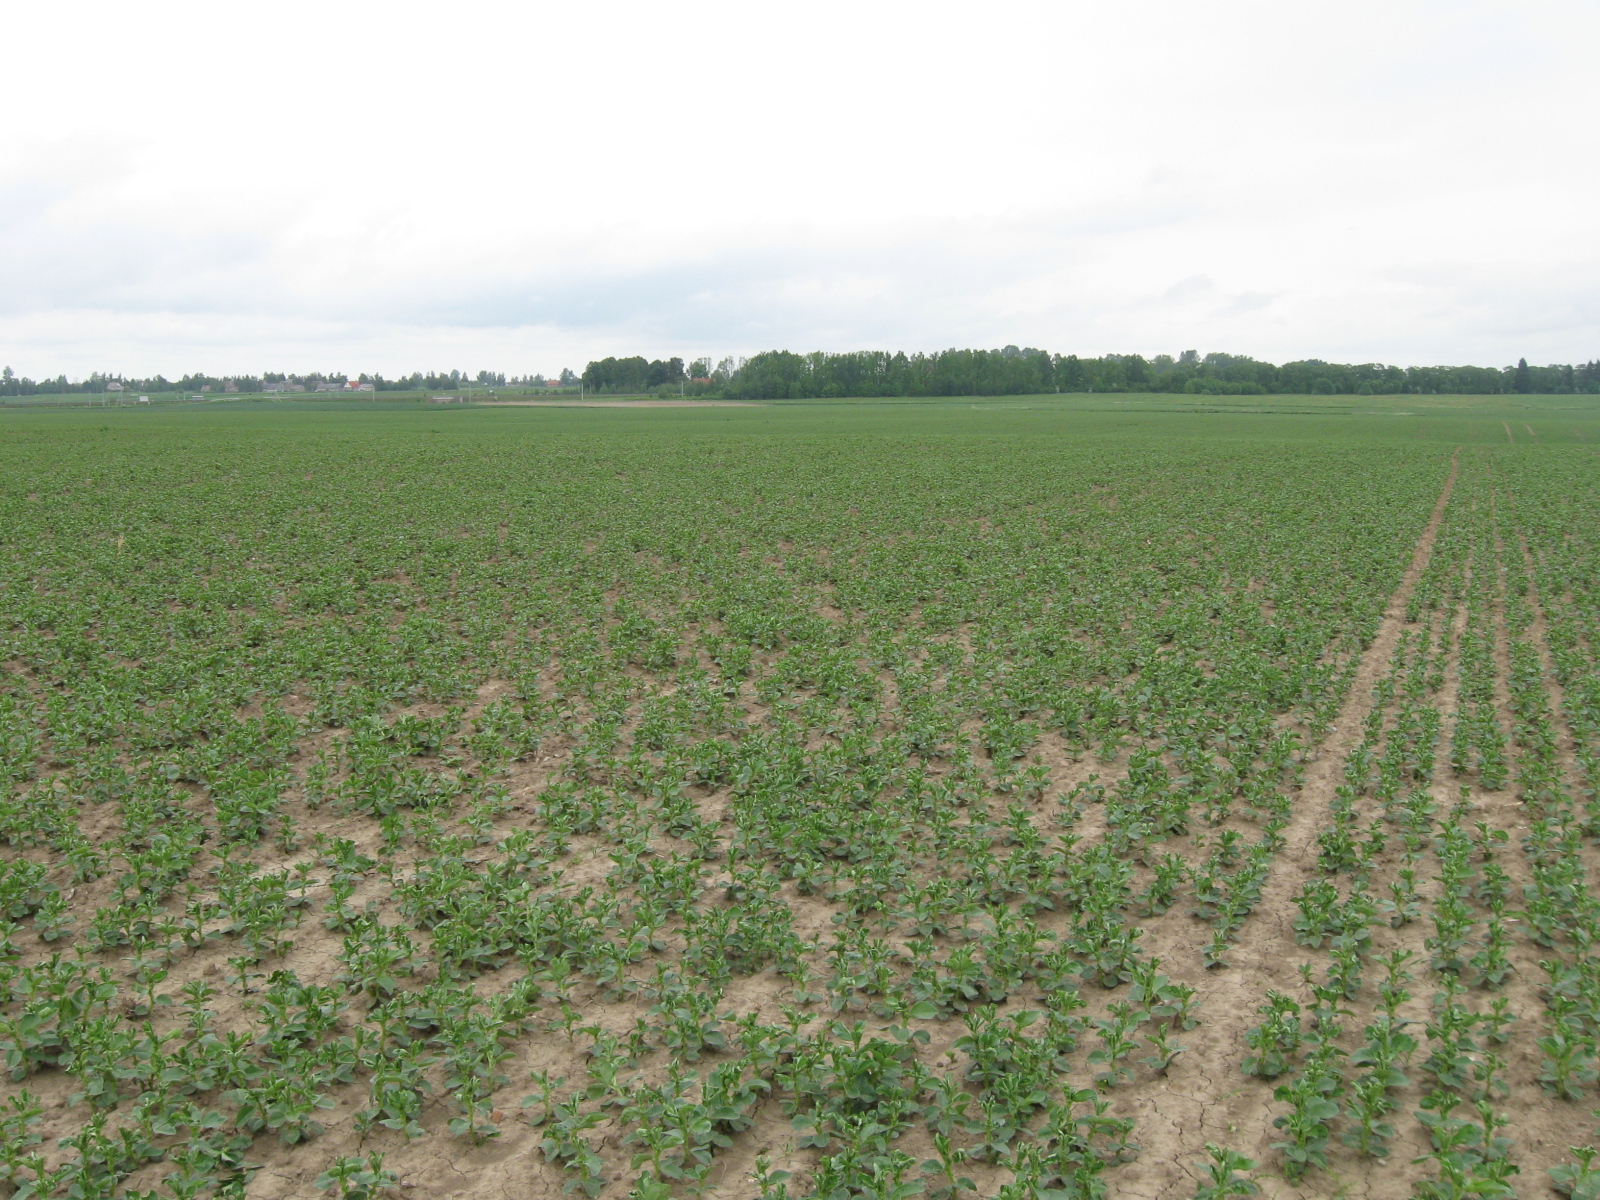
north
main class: Cropland
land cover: Dry pulses
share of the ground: 50 - 75 %
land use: Agriculture (excluding fallow land and kitchen gardens)
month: May
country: LT
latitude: 54.6446
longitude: 22.8539
